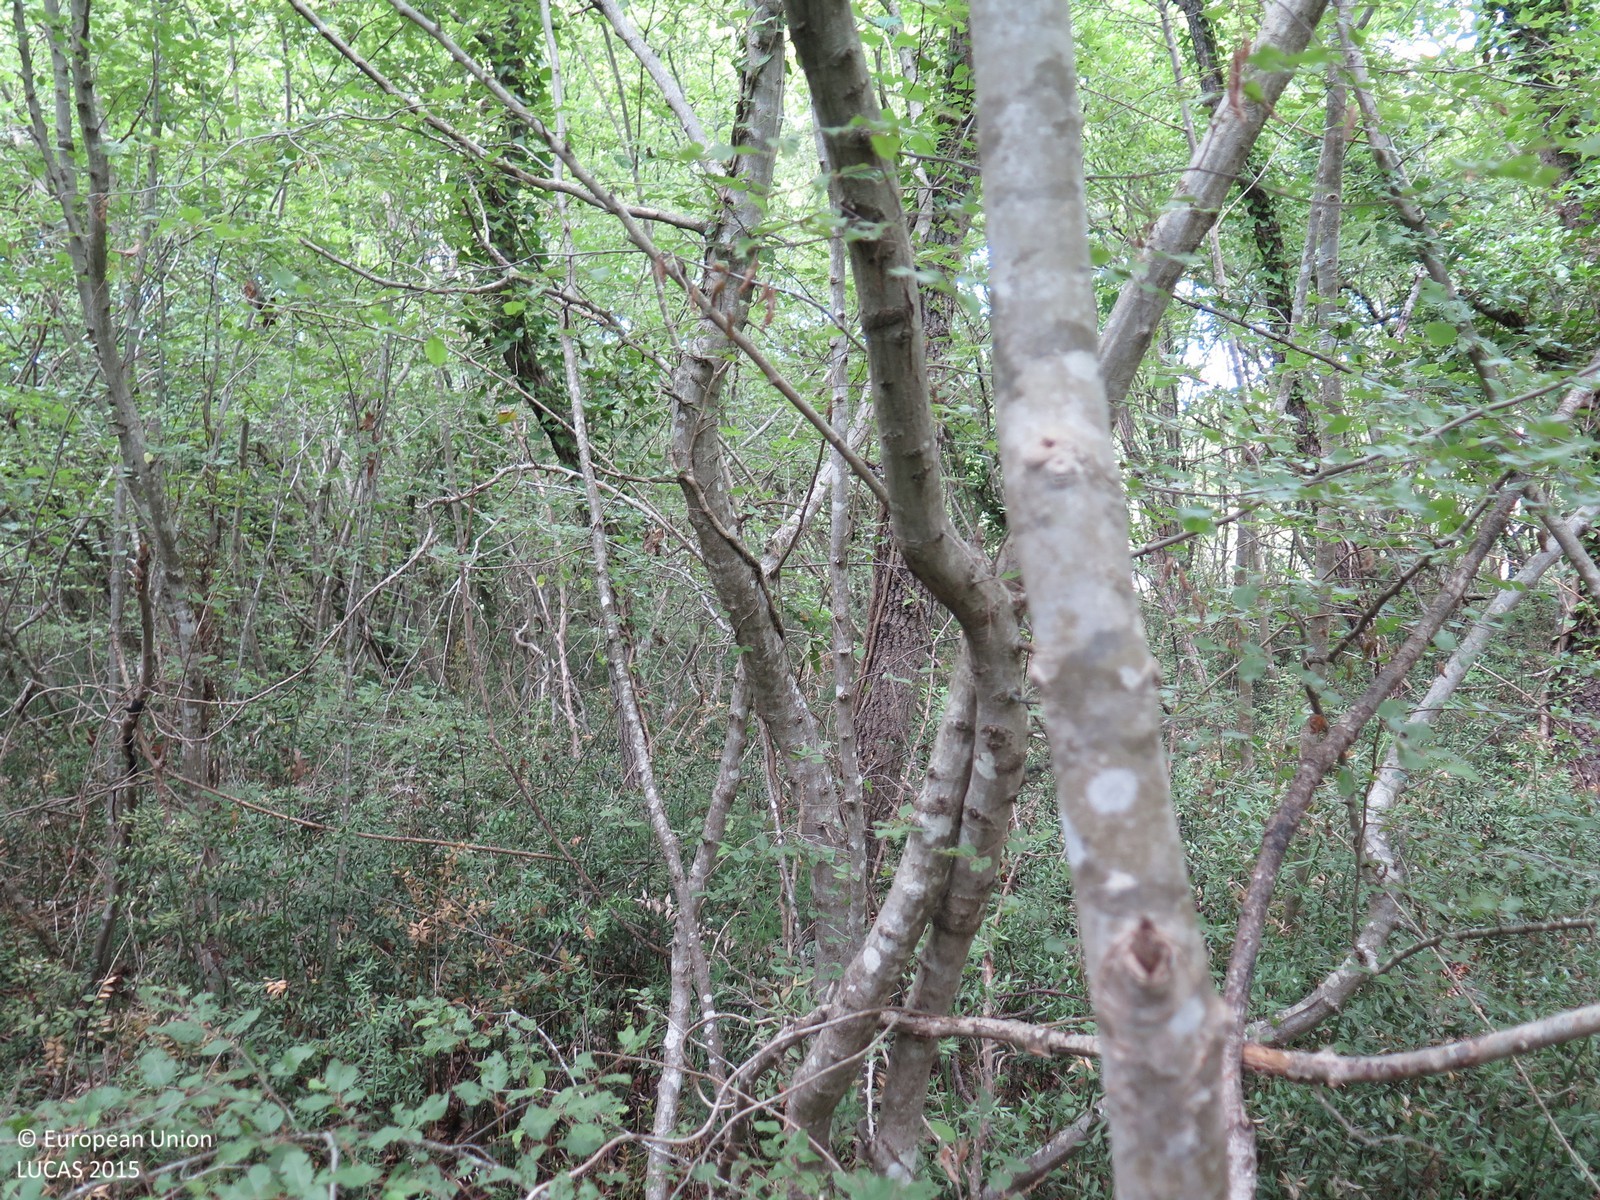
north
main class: Woodland
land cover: Broadleaved woodland
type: beech forest
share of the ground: > 75 %
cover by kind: broadleaved forest trees 95 %, shrubs 5 %
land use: Semi-natural and natural areas not in use
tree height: > 5 m
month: June
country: HR
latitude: 45.2428
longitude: 13.6512
